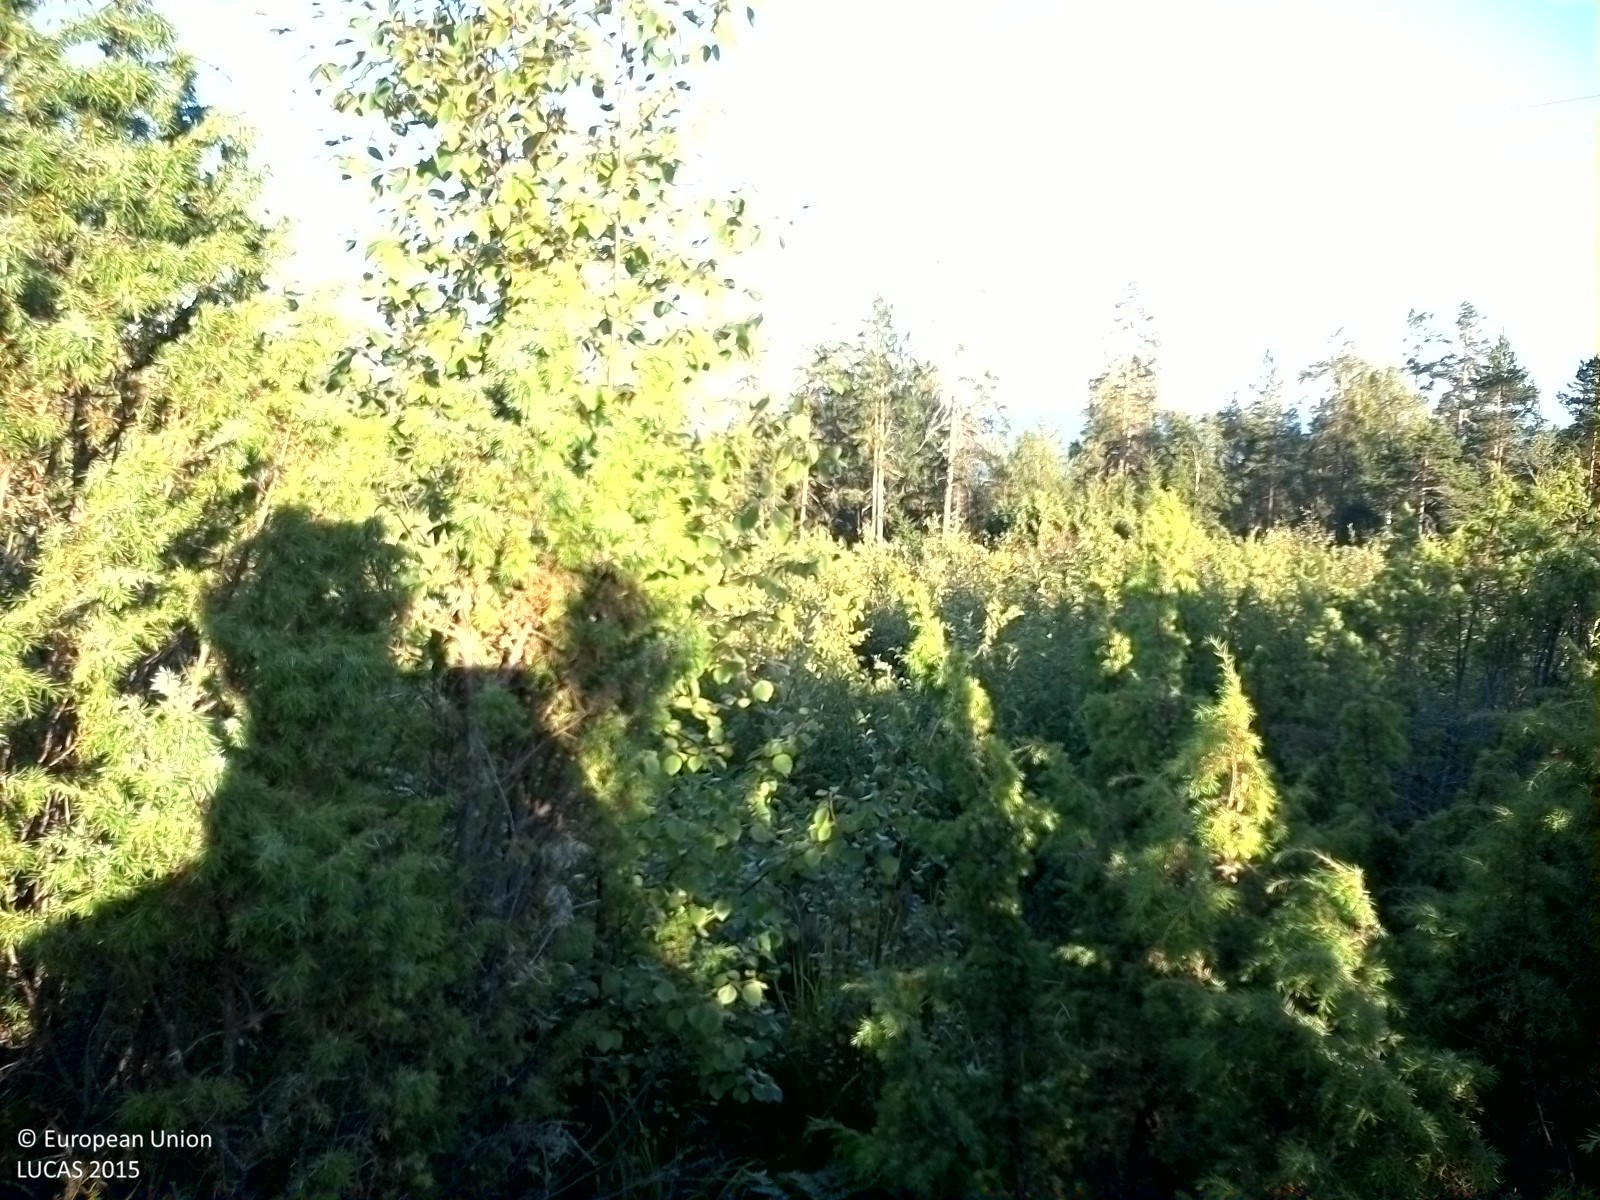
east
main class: Woodland
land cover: Pine dominated mixed woodland
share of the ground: 50 - 75 %
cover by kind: coniferous forest trees 35 %, shrubs 35 %, broadleaved forest trees 20 %, herbaceous plants 10 %
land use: Electricity, gas and thermal power distribution
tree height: < 5 m
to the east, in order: Pine dominated mixed woodland; Electric lines; Shrubland with sparse tree cover; Other coniferous woodland; Other mixed woodland; Pine dominated mixed woodland
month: August
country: SE
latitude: 62.3790
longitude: 16.9598
